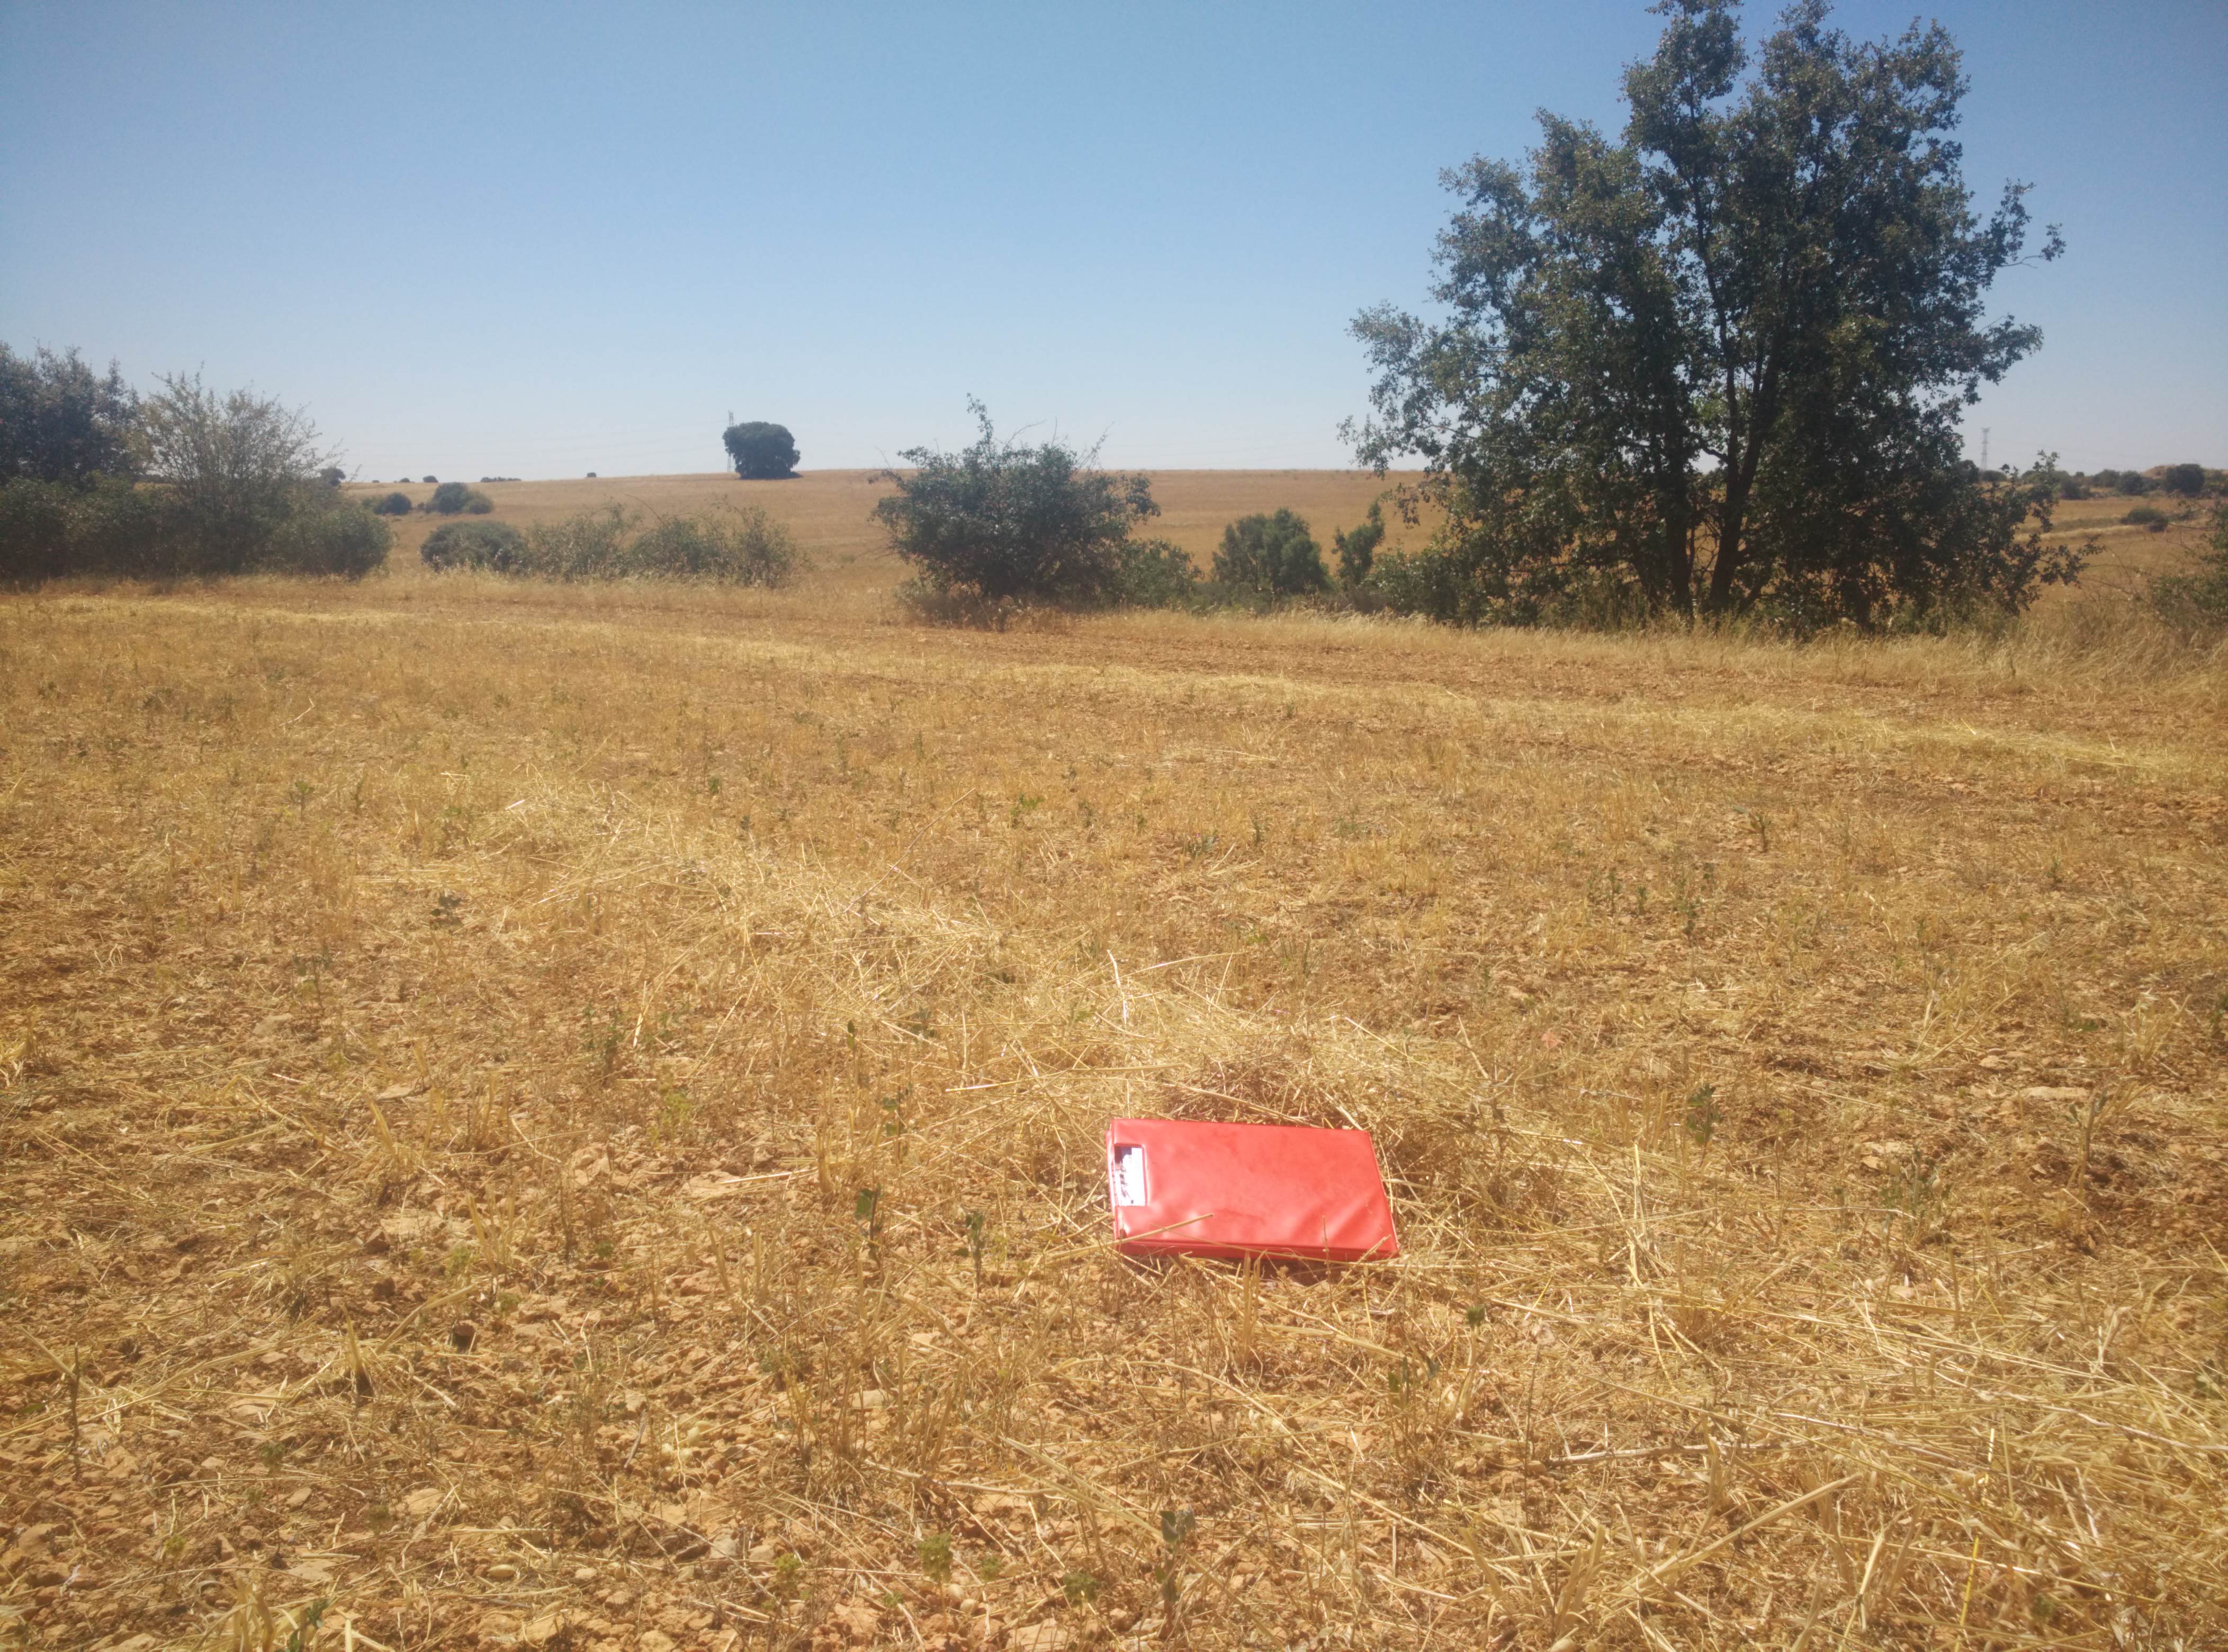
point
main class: Cropland
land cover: Common wheat
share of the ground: < 10 %
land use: Agriculture (excluding fallow land and kitchen gardens)
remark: Harvested field
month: July
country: ES
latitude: 40.6279
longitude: -2.8329
